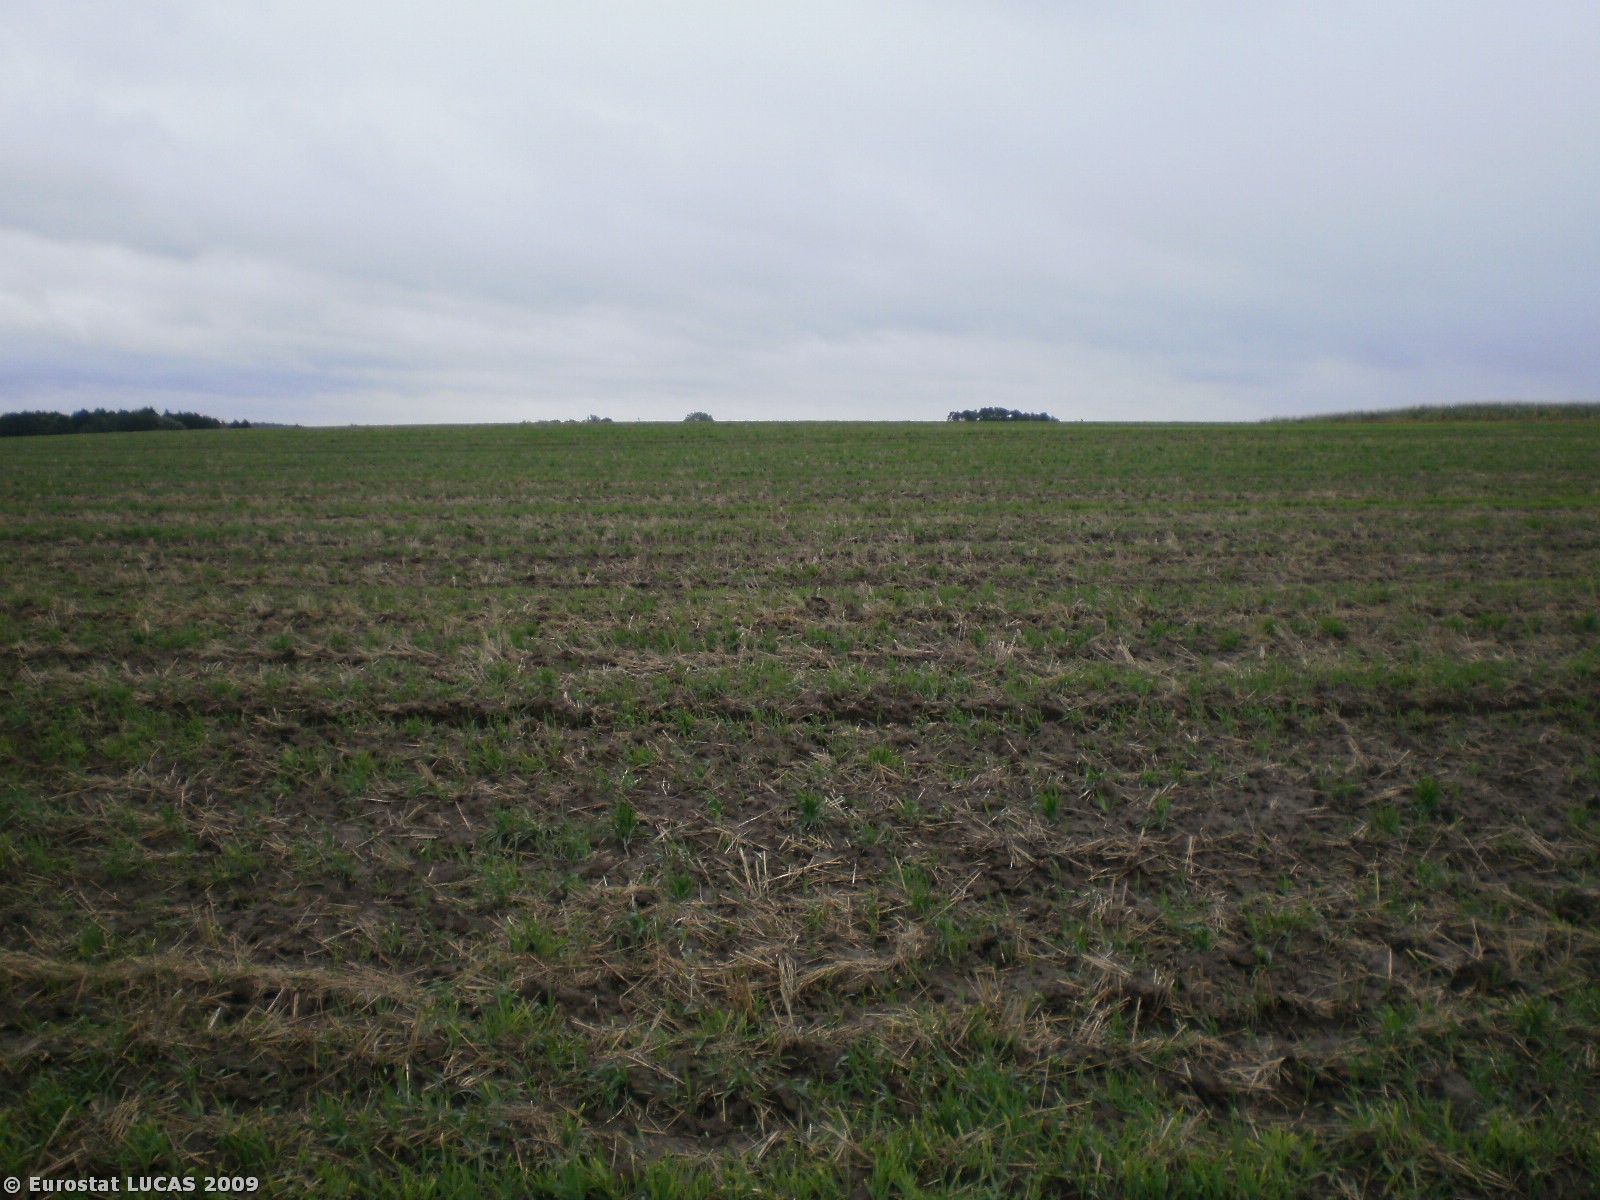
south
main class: Cropland
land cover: Barley
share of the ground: < 10 %
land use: Agriculture (excluding fallow land and kitchen gardens)
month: September
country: PL
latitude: 53.6256
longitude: 17.7090
